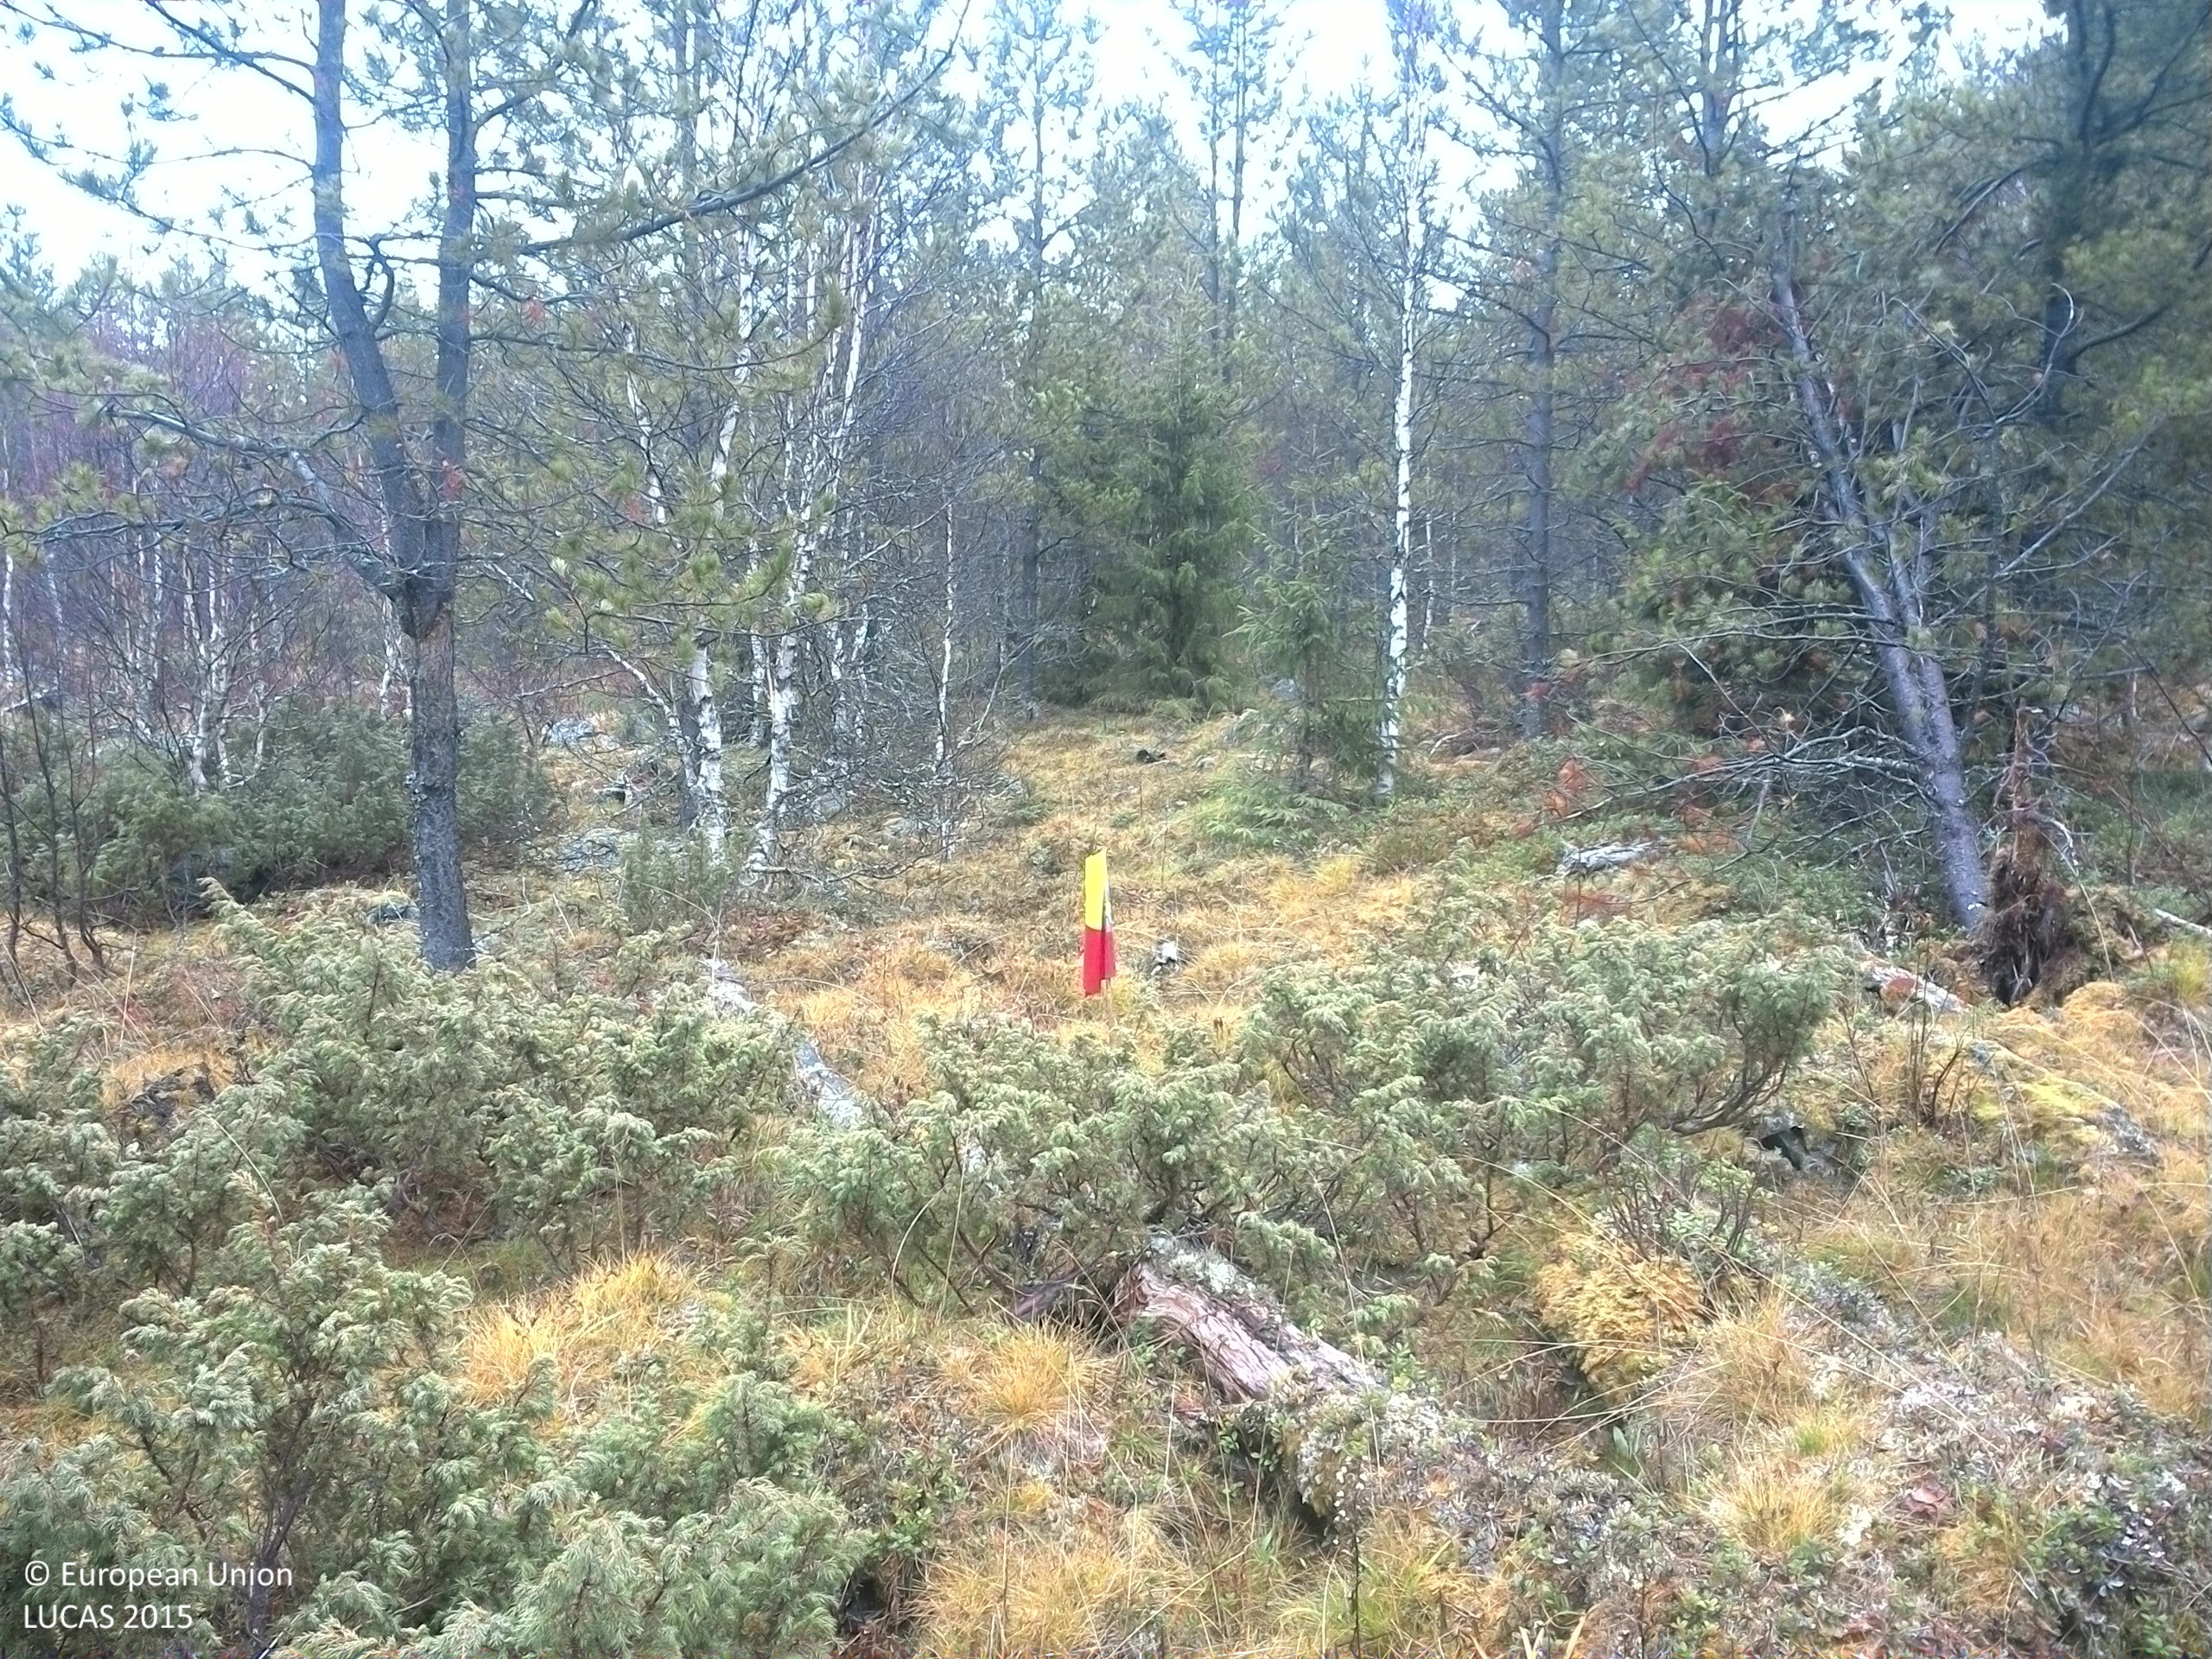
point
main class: Woodland
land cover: Pine dominated mixed woodland
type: exotic forest
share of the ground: 25 - 50 %
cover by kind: coniferous forest trees 30 %, herbaceous plants 25 %, shrubs 20 %, broadleaved forest trees 10 %, lichens and mosses 10 %, consolidated bare surface 5 %
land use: Forestry
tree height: > 5 m
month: October
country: SE
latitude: 64.3211
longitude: 15.4935
